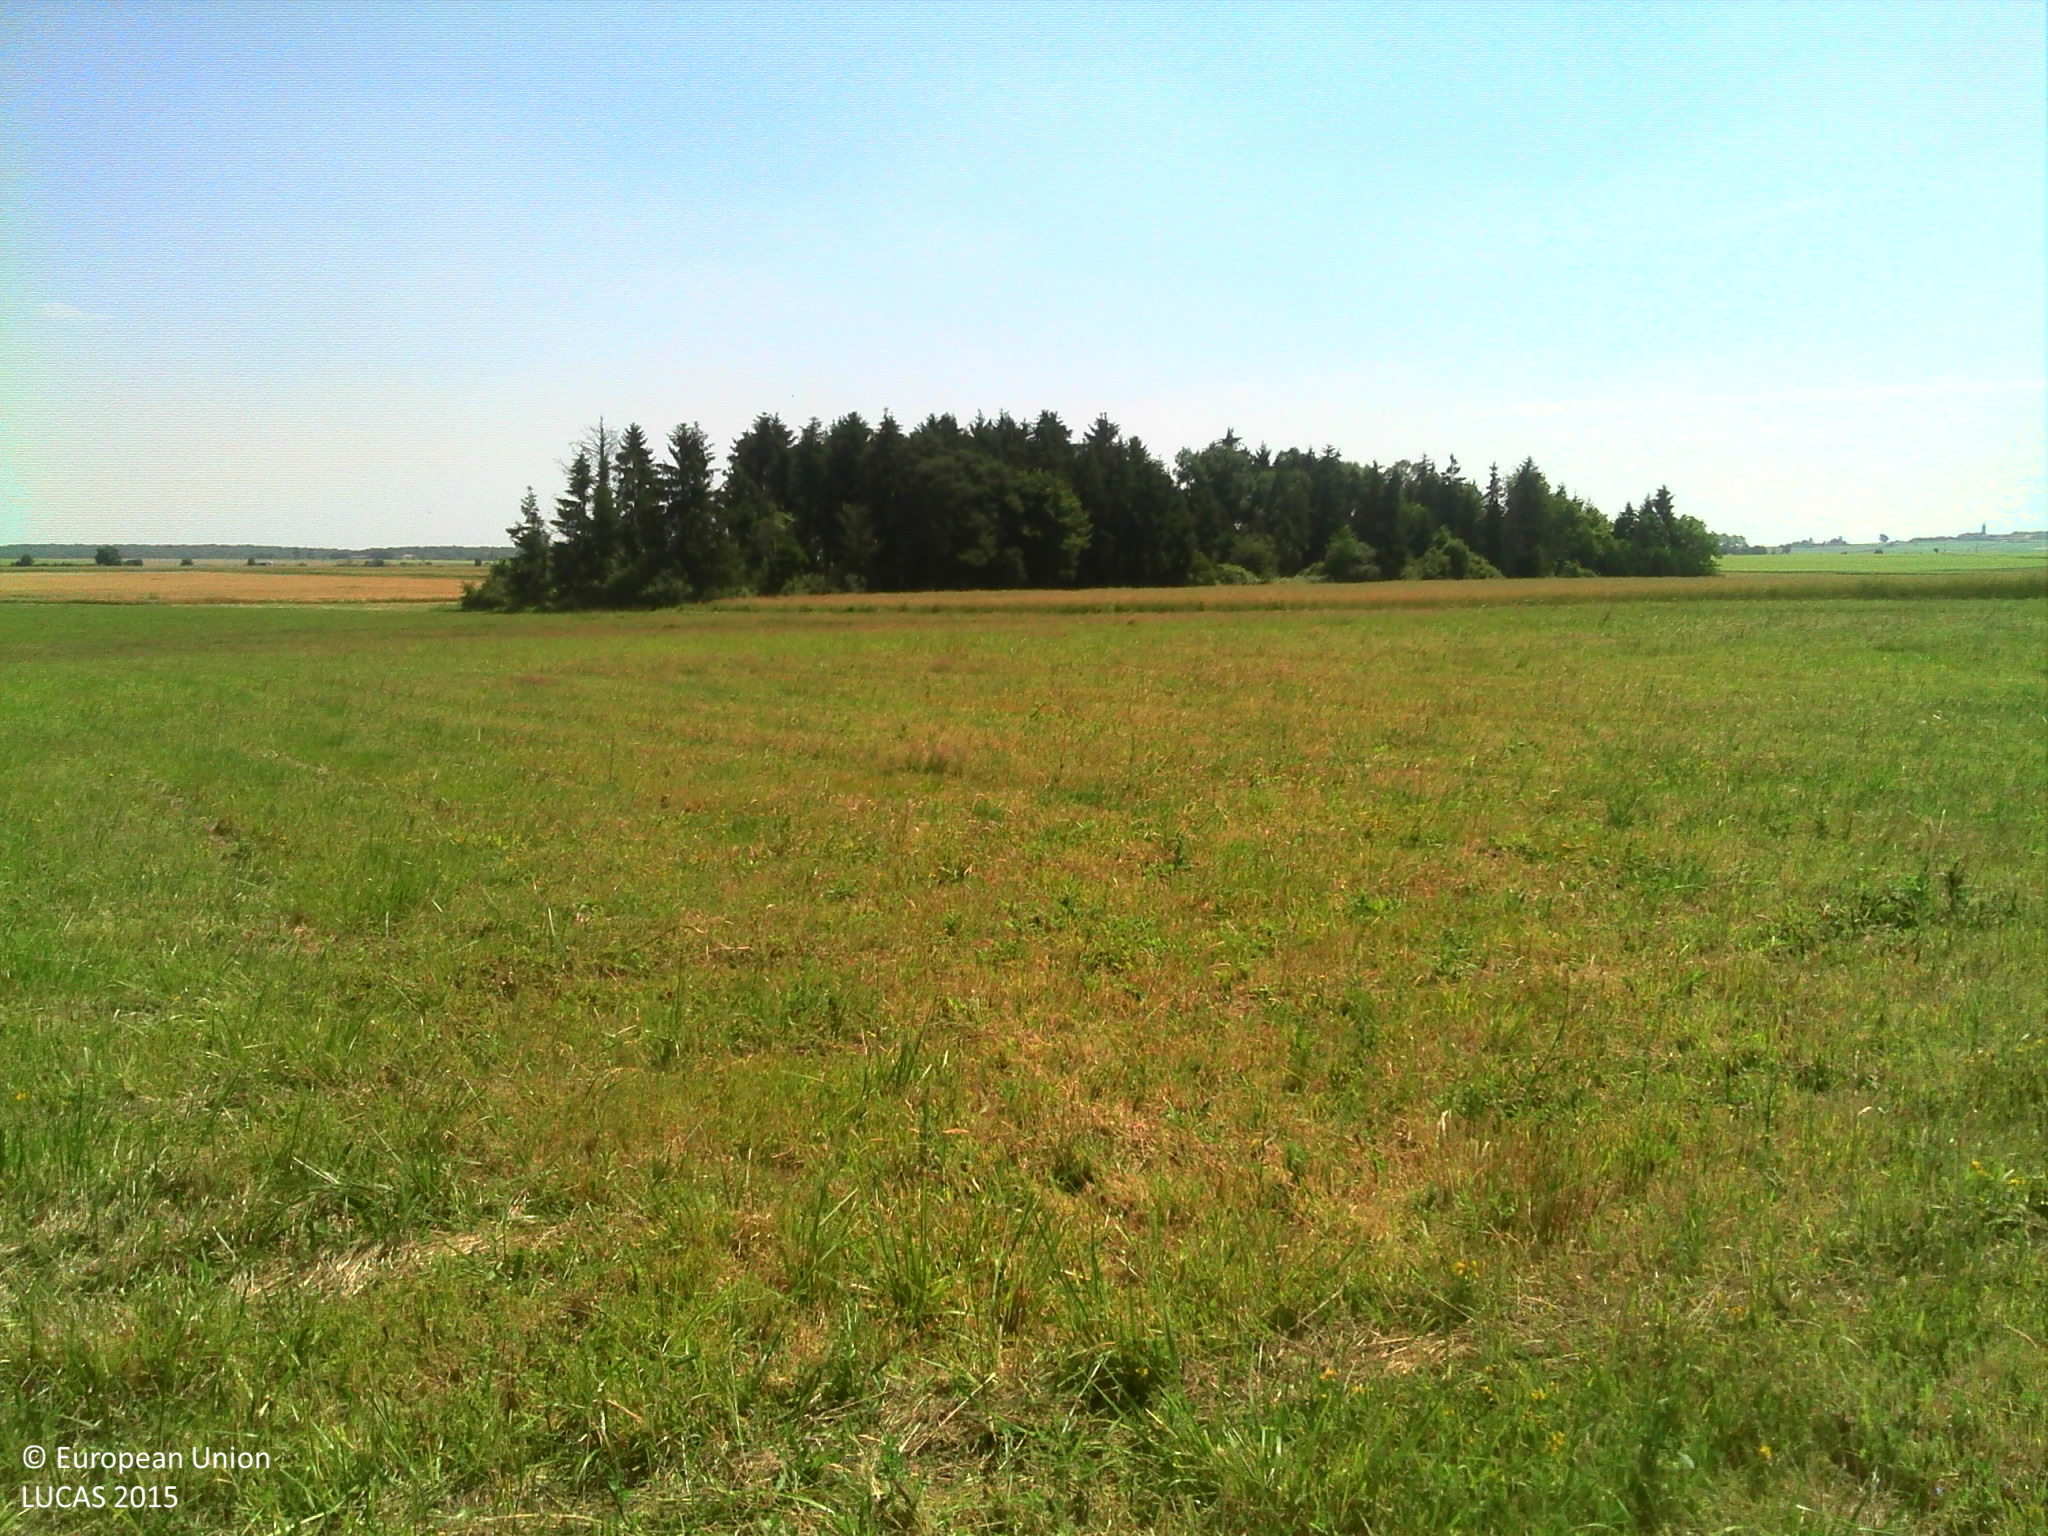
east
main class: Grassland
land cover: Grassland without tree/shrub cover
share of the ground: > 75 %
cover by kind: herbaceous plants 100 %
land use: Agriculture (excluding fallow land and kitchen gardens)
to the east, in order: Grassland without tree/shrub cover; Rape and turnip rape; Spruce dominated mixed woodland; Grassland without tree/shrub cover
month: June
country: FR
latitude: 47.3271
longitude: 2.9153
